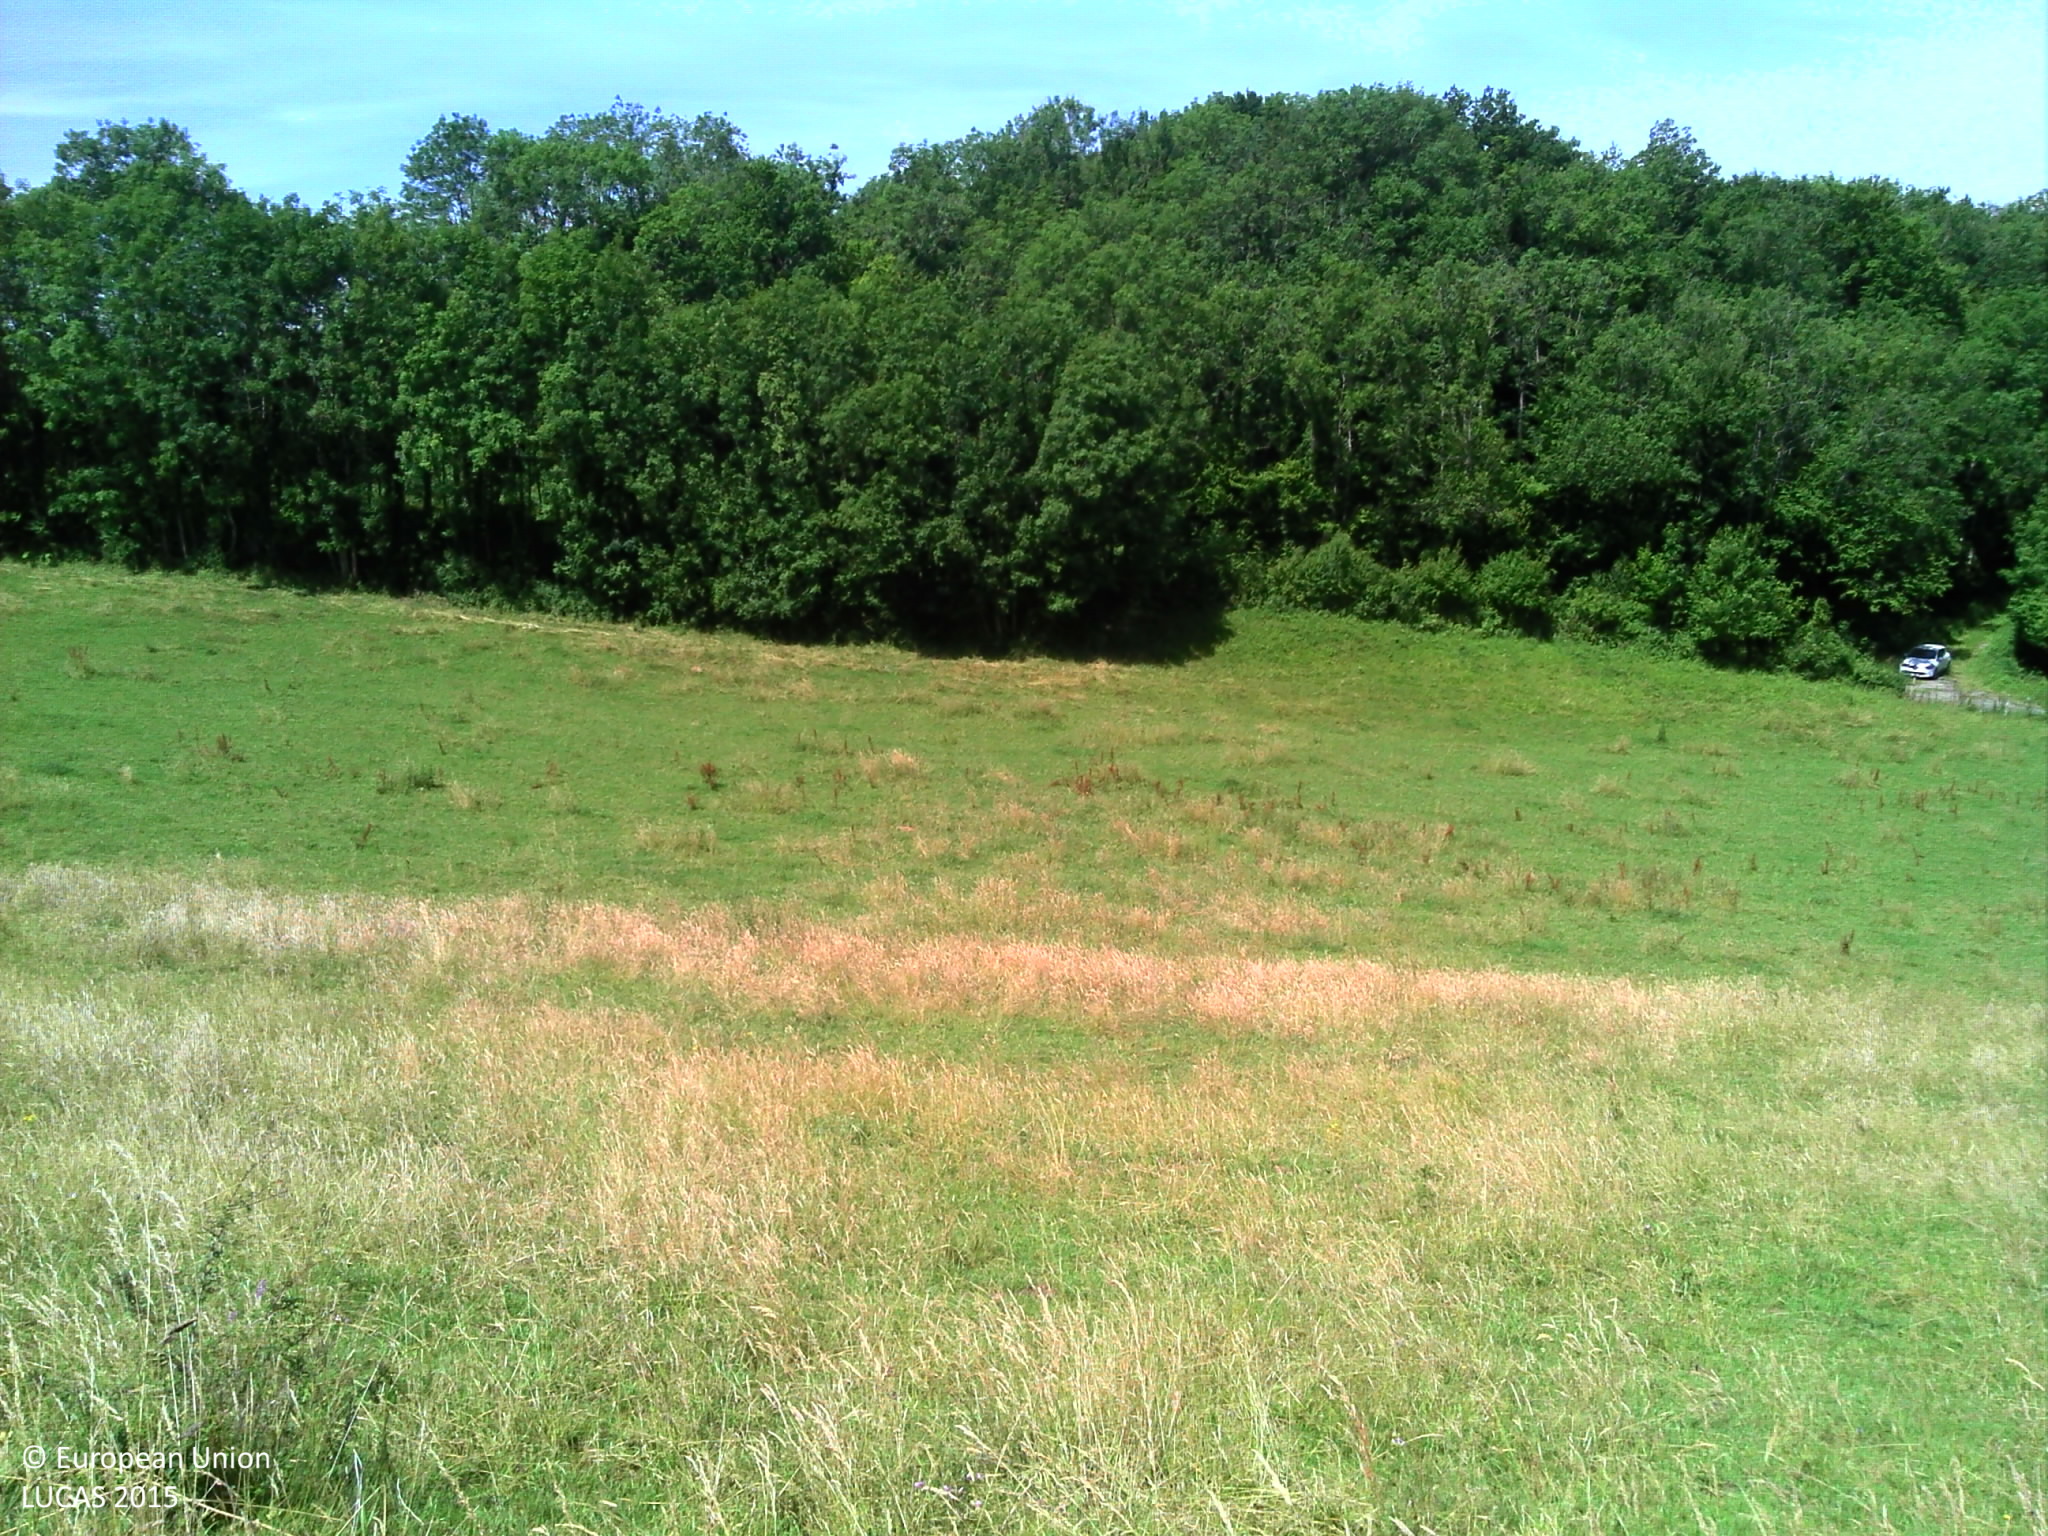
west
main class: Grassland
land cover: Grassland without tree/shrub cover
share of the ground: > 75 %
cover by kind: herbaceous plants 100 %
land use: Agriculture (excluding fallow land and kitchen gardens)
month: June
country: FR
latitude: 46.4554
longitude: 5.5110
